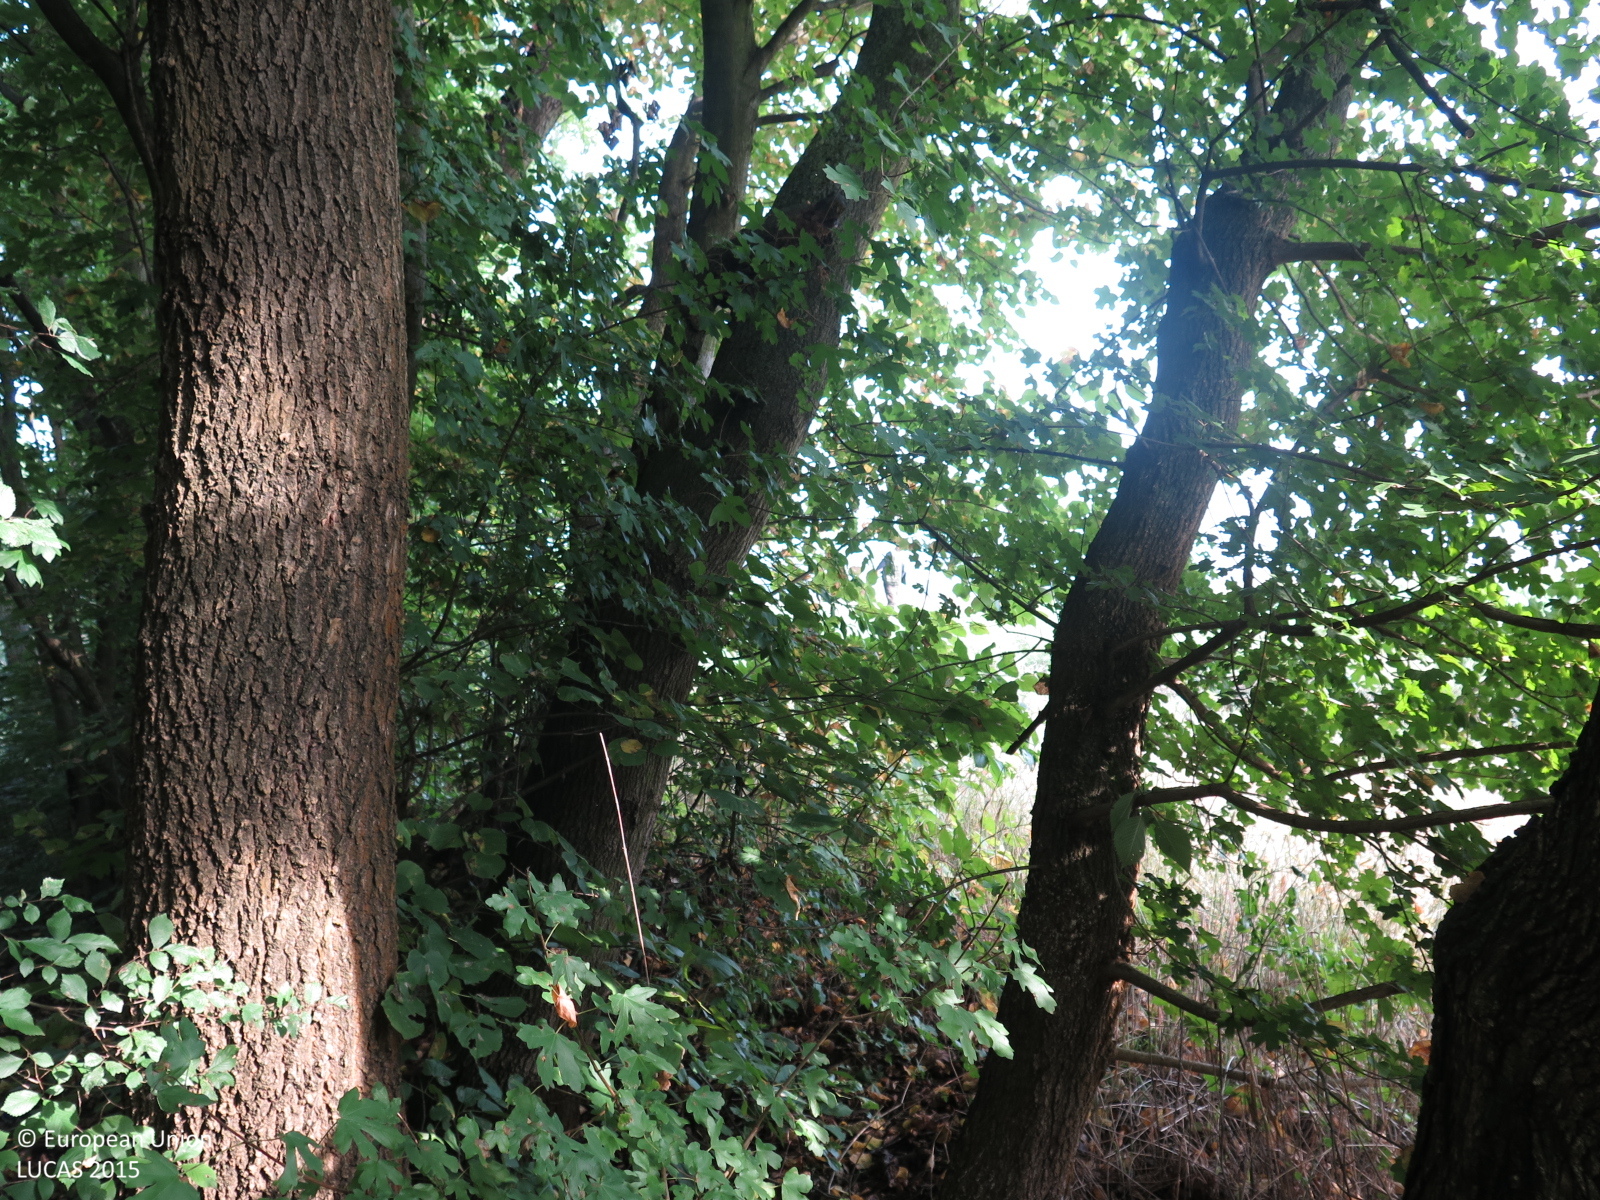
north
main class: Woodland
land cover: Broadleaved woodland
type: floodplain forest
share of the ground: > 75 %
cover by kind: broadleaved forest trees 90 %, herbaceous plants 10 %
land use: Forestry
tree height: > 5 m
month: August
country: CZ
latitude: 48.7278
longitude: 16.9279
